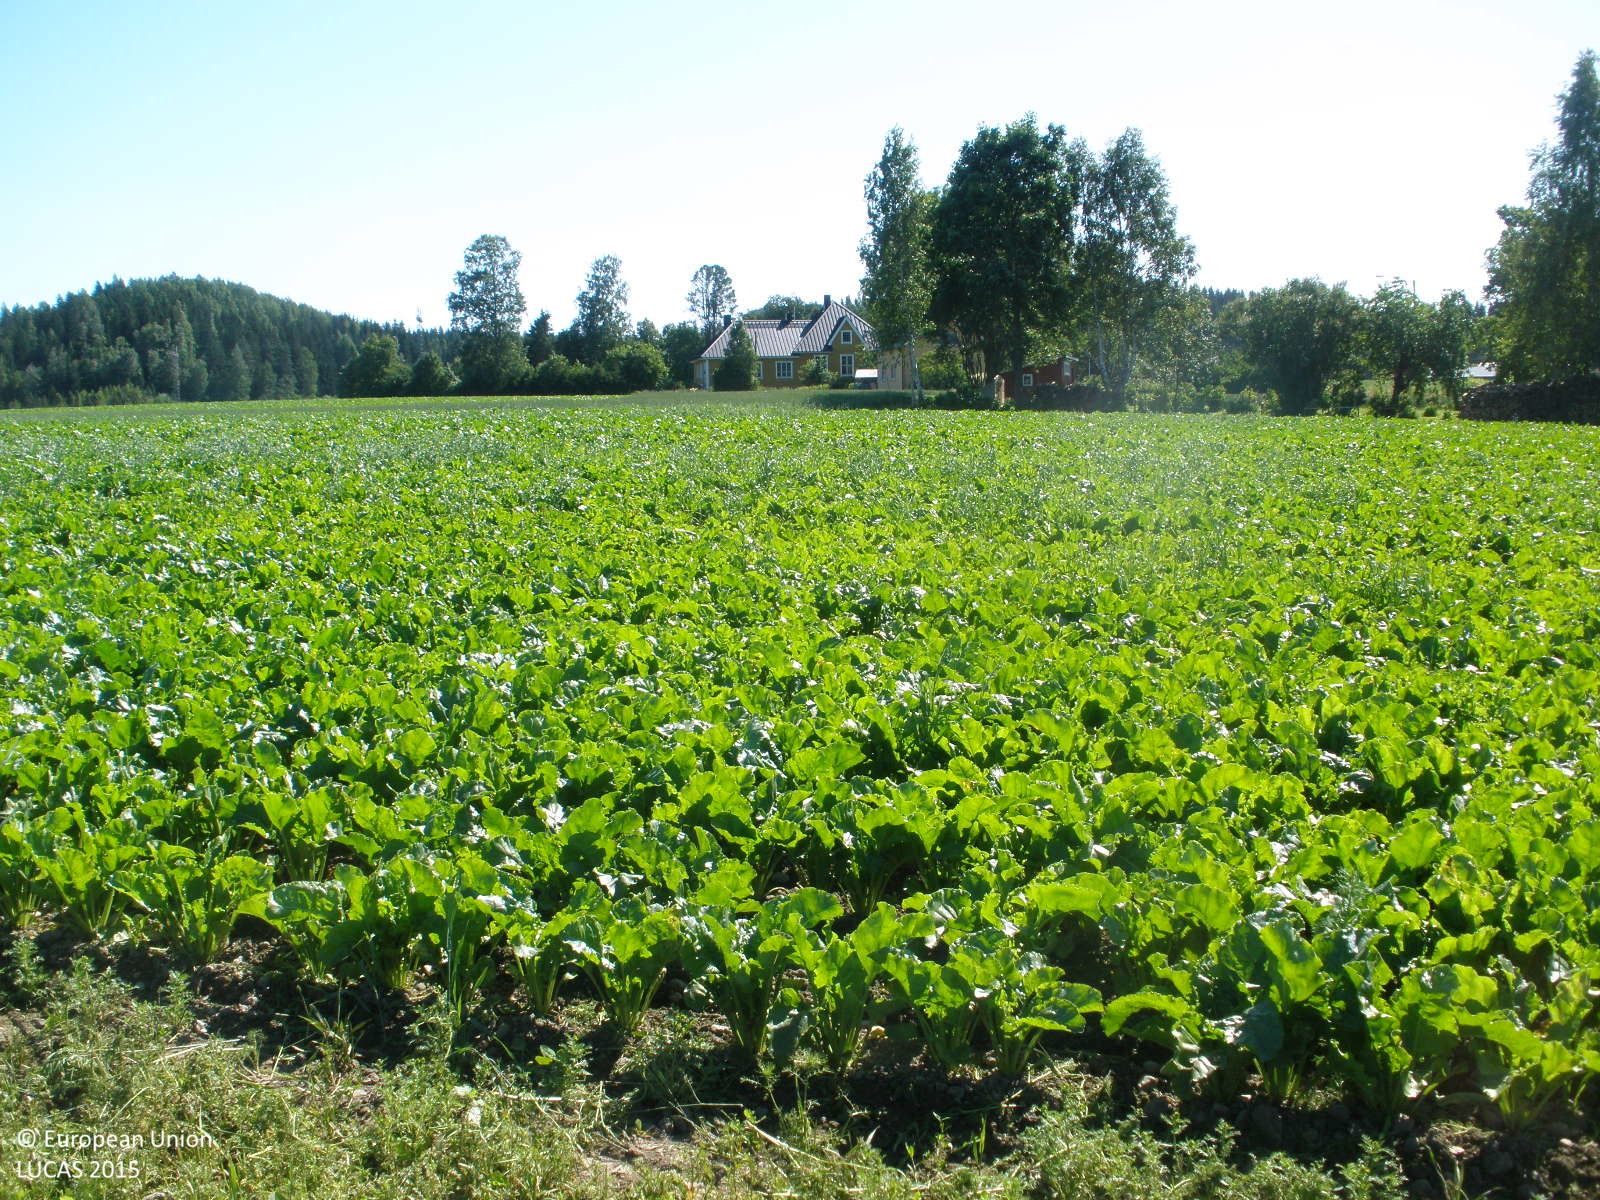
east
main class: Artificial land
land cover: Non built-up linear features
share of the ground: > 75 %
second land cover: Grassland without tree/shrub cover
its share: > 75 %
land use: Road transport
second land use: Agriculture (excluding fallow land and kitchen gardens)
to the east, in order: Grass margins; Other fresh vegetables; Common wheat; Other fresh vegetables; Common wheat; Broadleaved woodland; Artificial constructions in urban areas
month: July
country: FI
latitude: 61.0717
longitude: 24.9186
